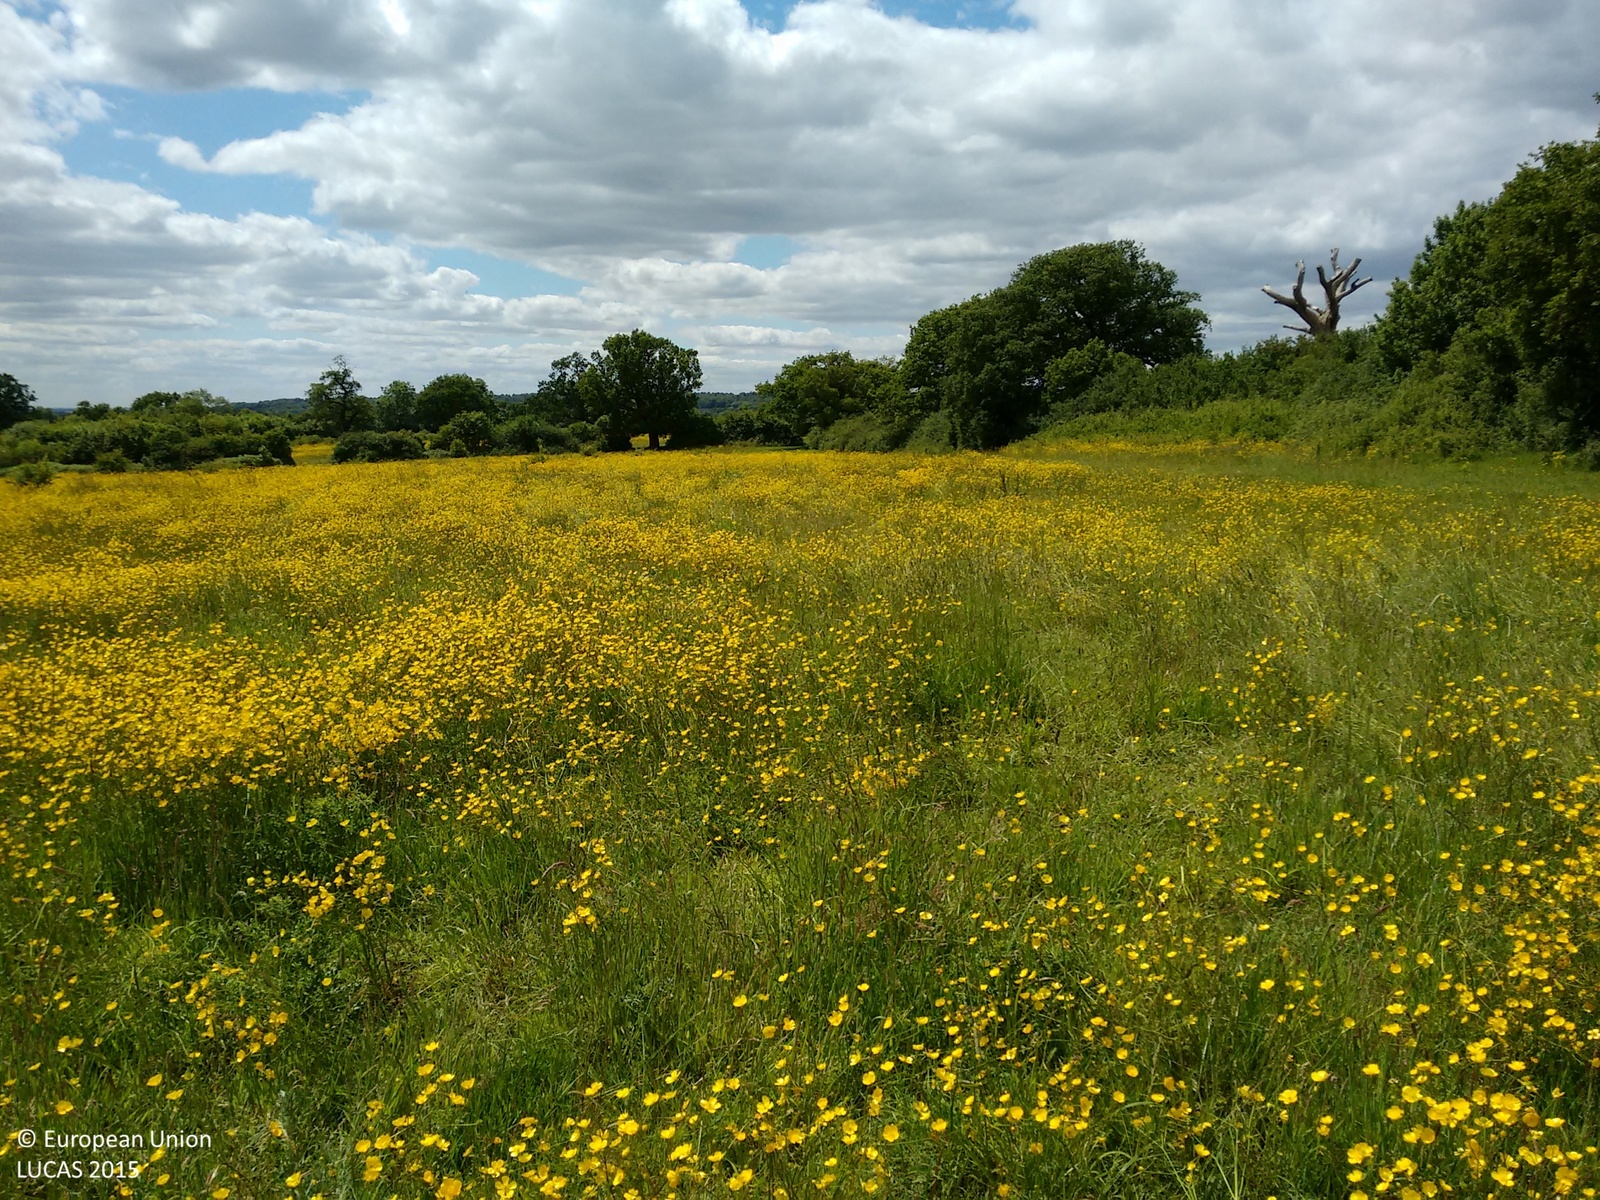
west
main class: Grassland
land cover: Grassland with sparse tree/shrub cover
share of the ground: > 75 %
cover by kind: herbaceous plants 95 %, broadleaved forest trees 5 %
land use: Agriculture (excluding fallow land and kitchen gardens)
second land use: Amenities, museums, leisure
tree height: < 5 m
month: June
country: GB
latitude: 51.6323
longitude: -0.3668
